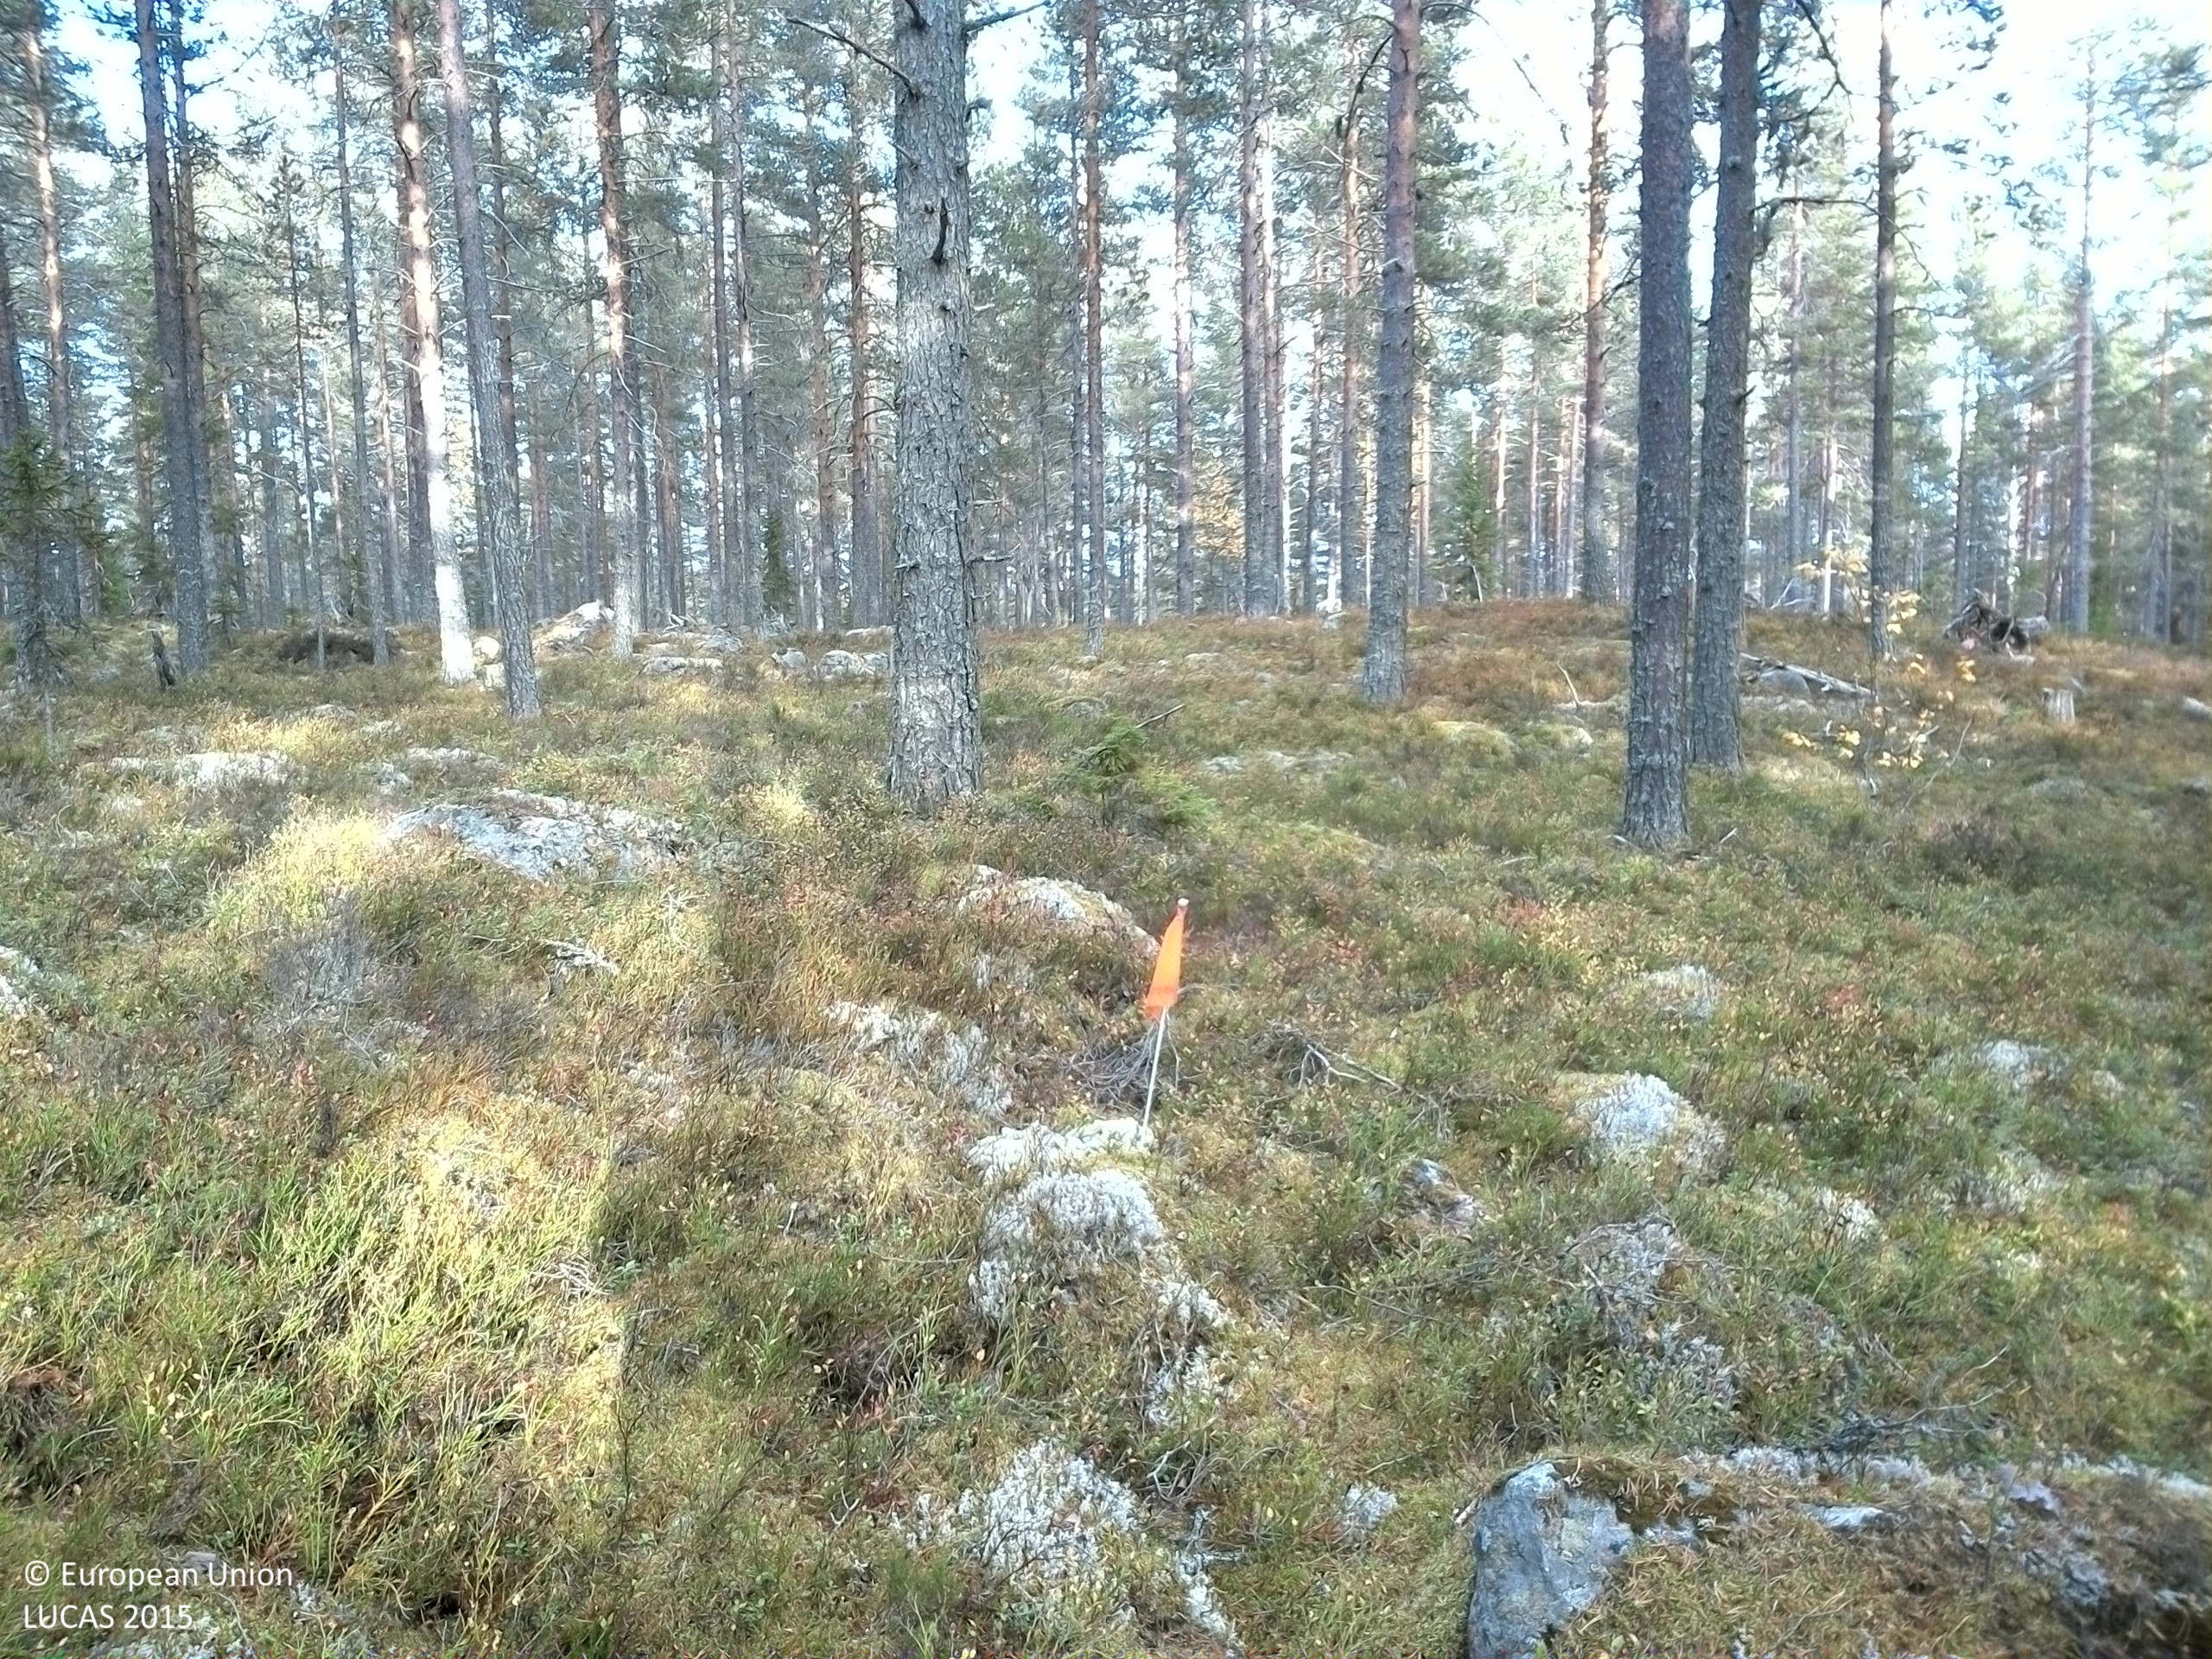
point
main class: Woodland
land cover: Pine dominated coniferous woodland
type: boreal forest
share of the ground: 50 - 75 %
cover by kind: coniferous forest trees 50 %, shrubs 25 %, lichens and mosses 15 %, consolidated bare surface 10 %
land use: Forestry
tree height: > 5 m
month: October
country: SE
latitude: 61.2830
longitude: 15.0039
